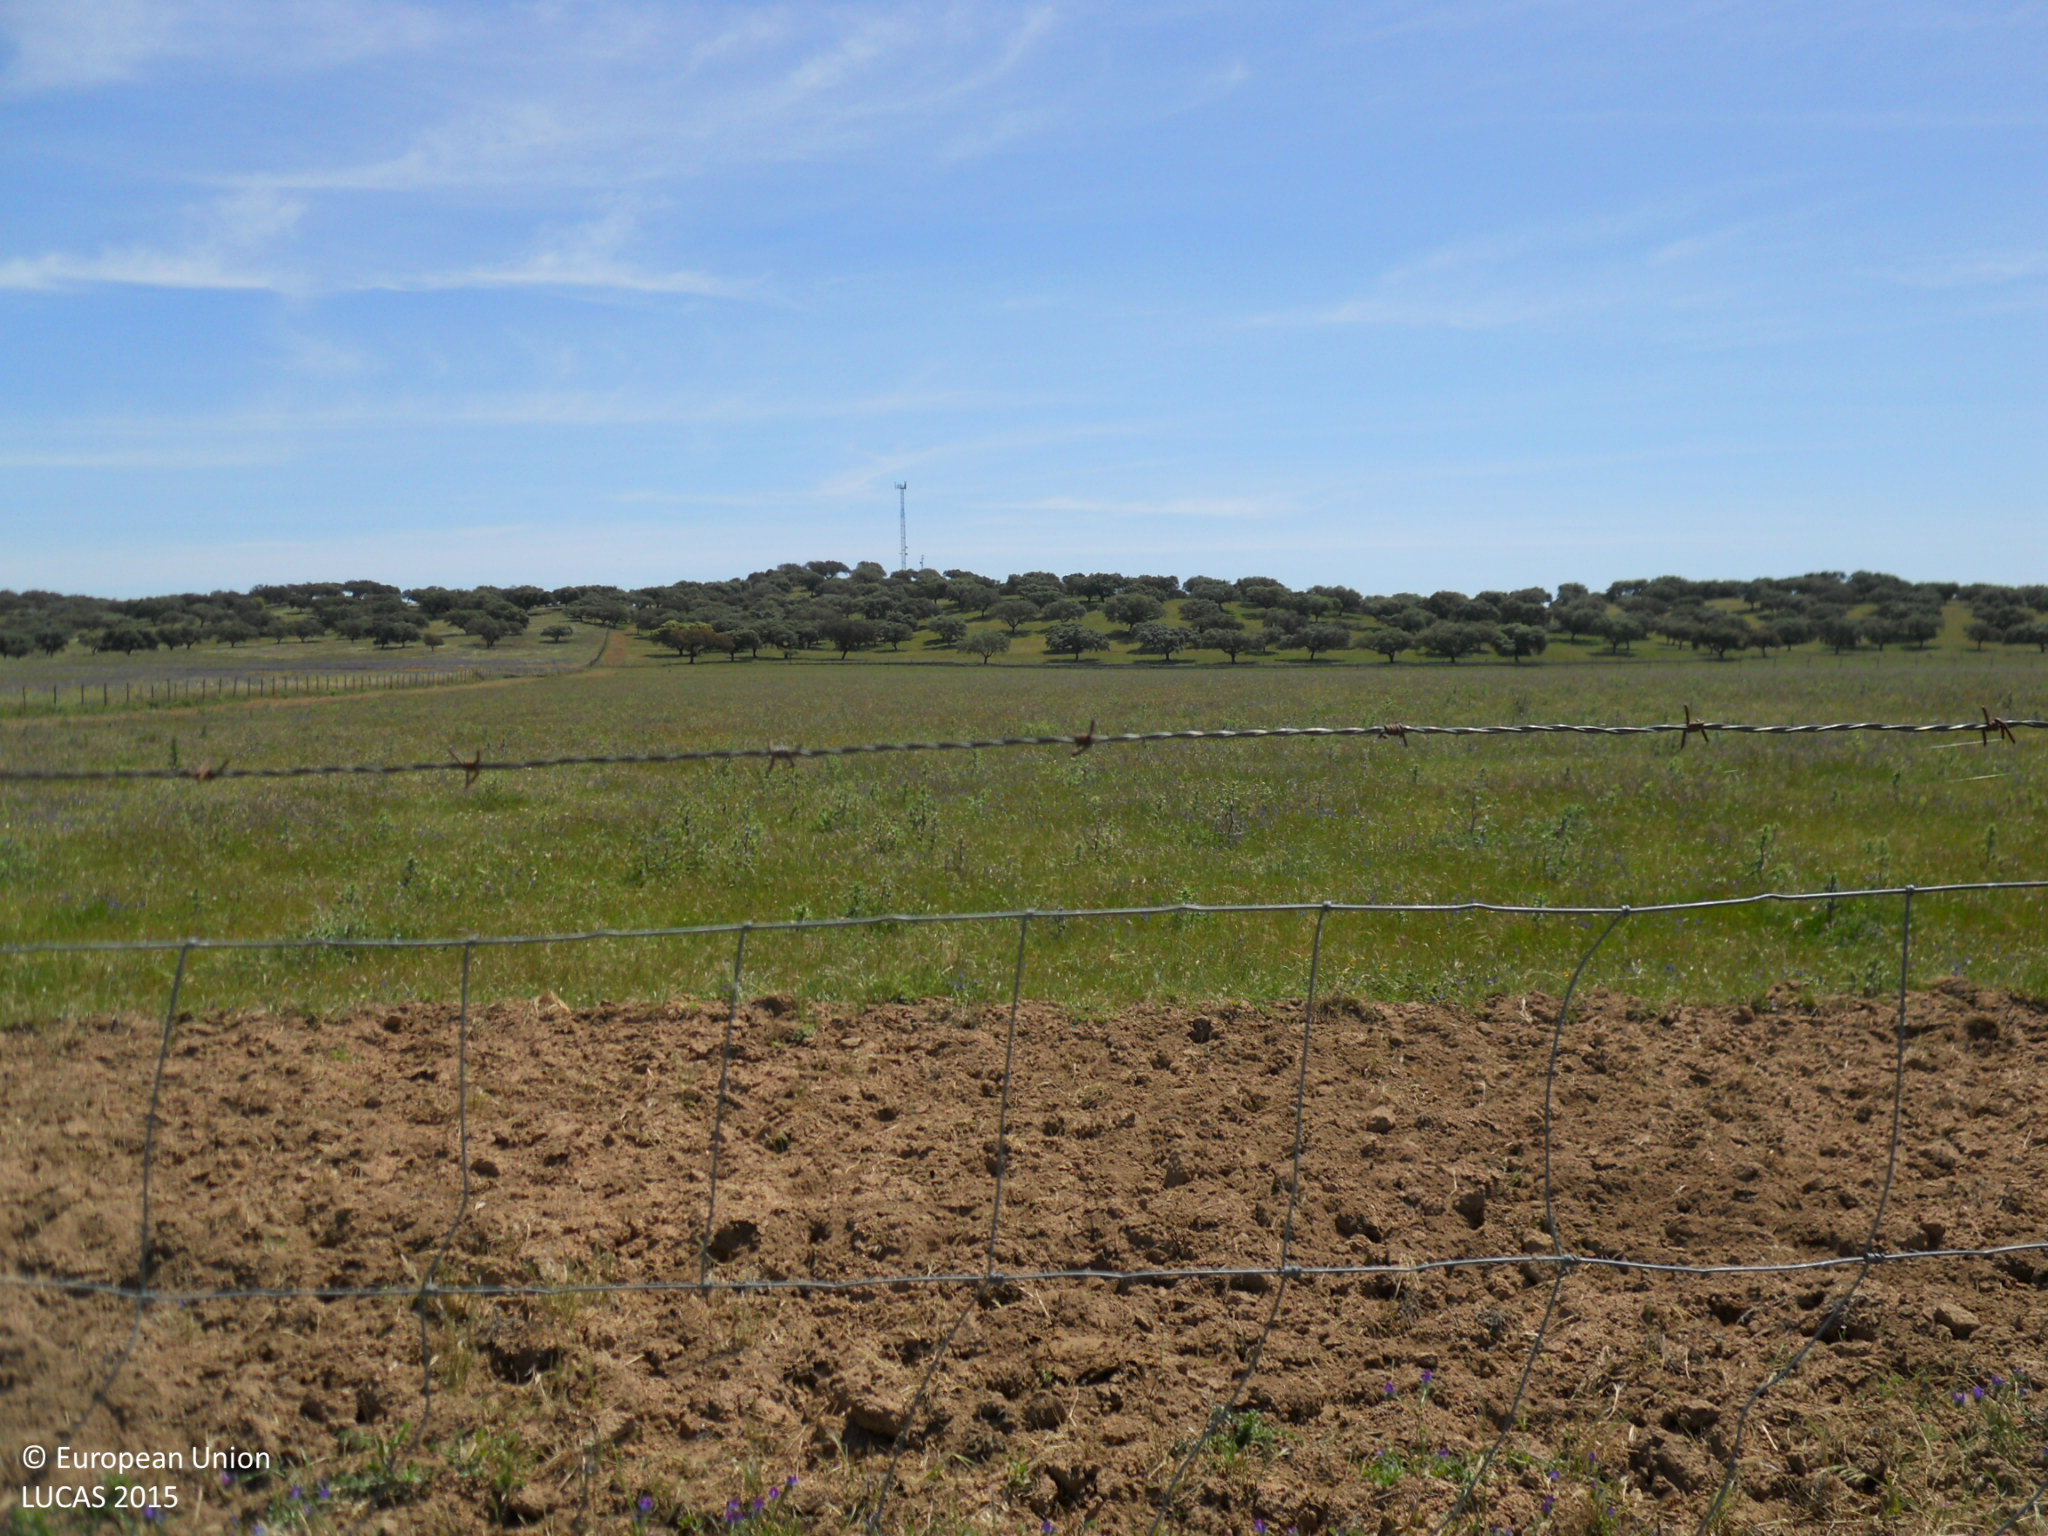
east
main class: Grassland
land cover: Grassland with sparse tree/shrub cover
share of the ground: > 75 %
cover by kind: herbaceous plants 95 %, broadleaved forest trees 5 %
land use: Agriculture (excluding fallow land and kitchen gardens)
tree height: > 5 m
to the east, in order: Grassland with sparse tree/shrub cover; Broadleaved woodland
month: April
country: ES
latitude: 39.0679
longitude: -6.8880
